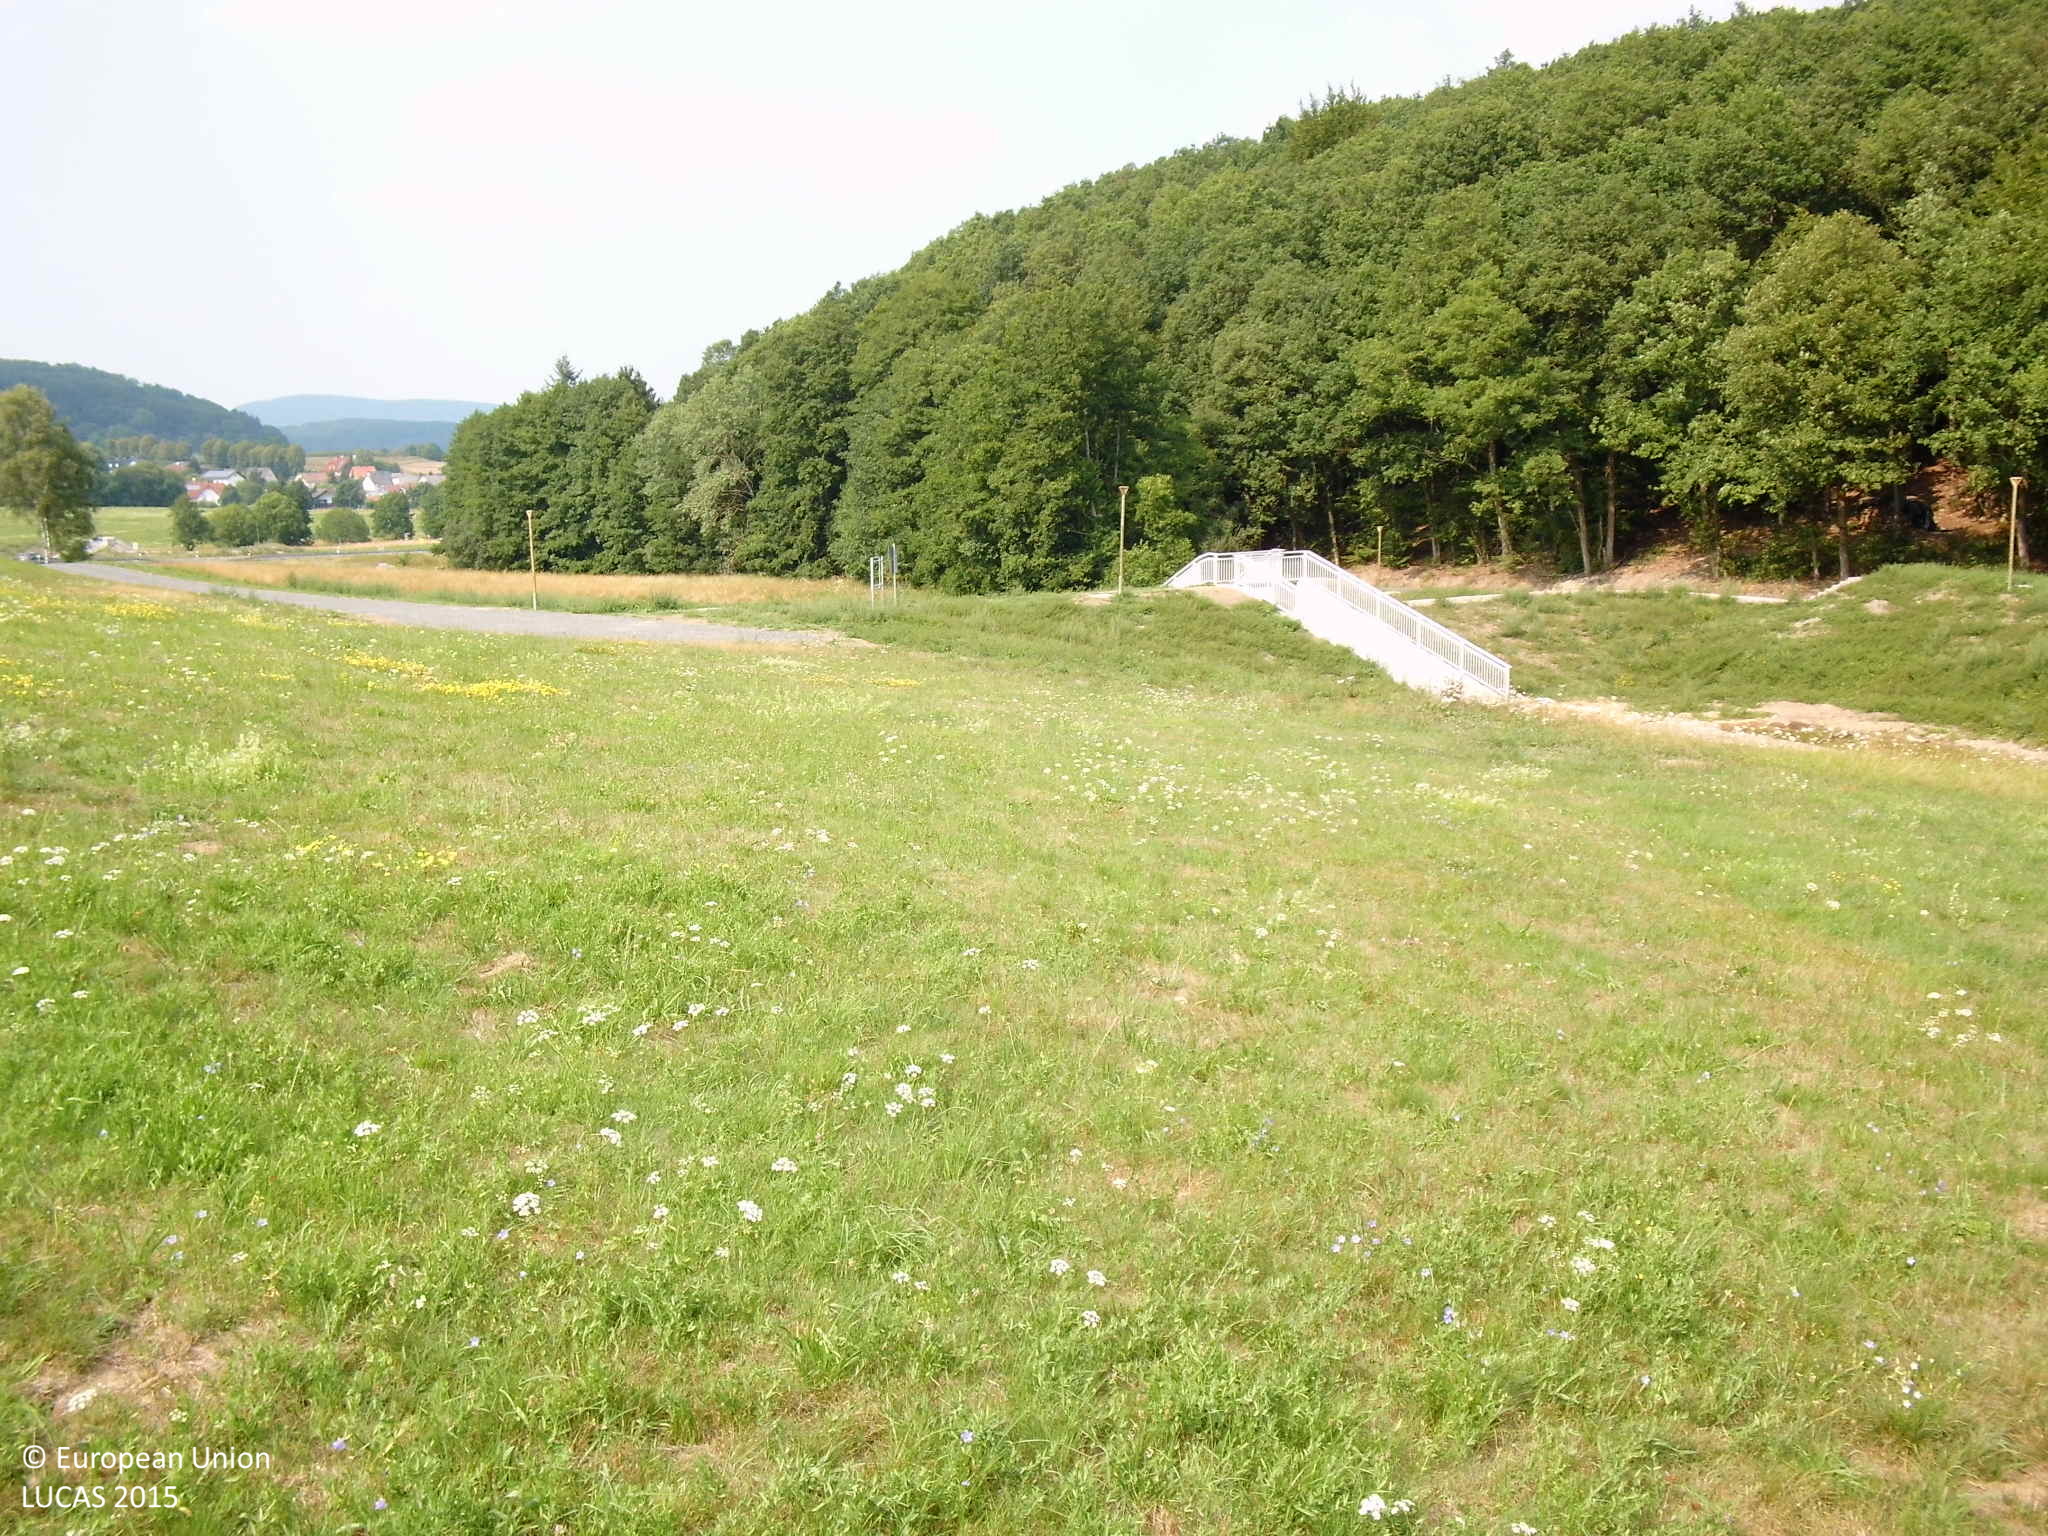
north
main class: Grassland
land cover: Grassland without tree/shrub cover
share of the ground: > 75 %
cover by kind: herbaceous plants 100 %
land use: Agriculture (excluding fallow land and kitchen gardens)
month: August
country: DE
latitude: 50.6612
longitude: 8.5998
